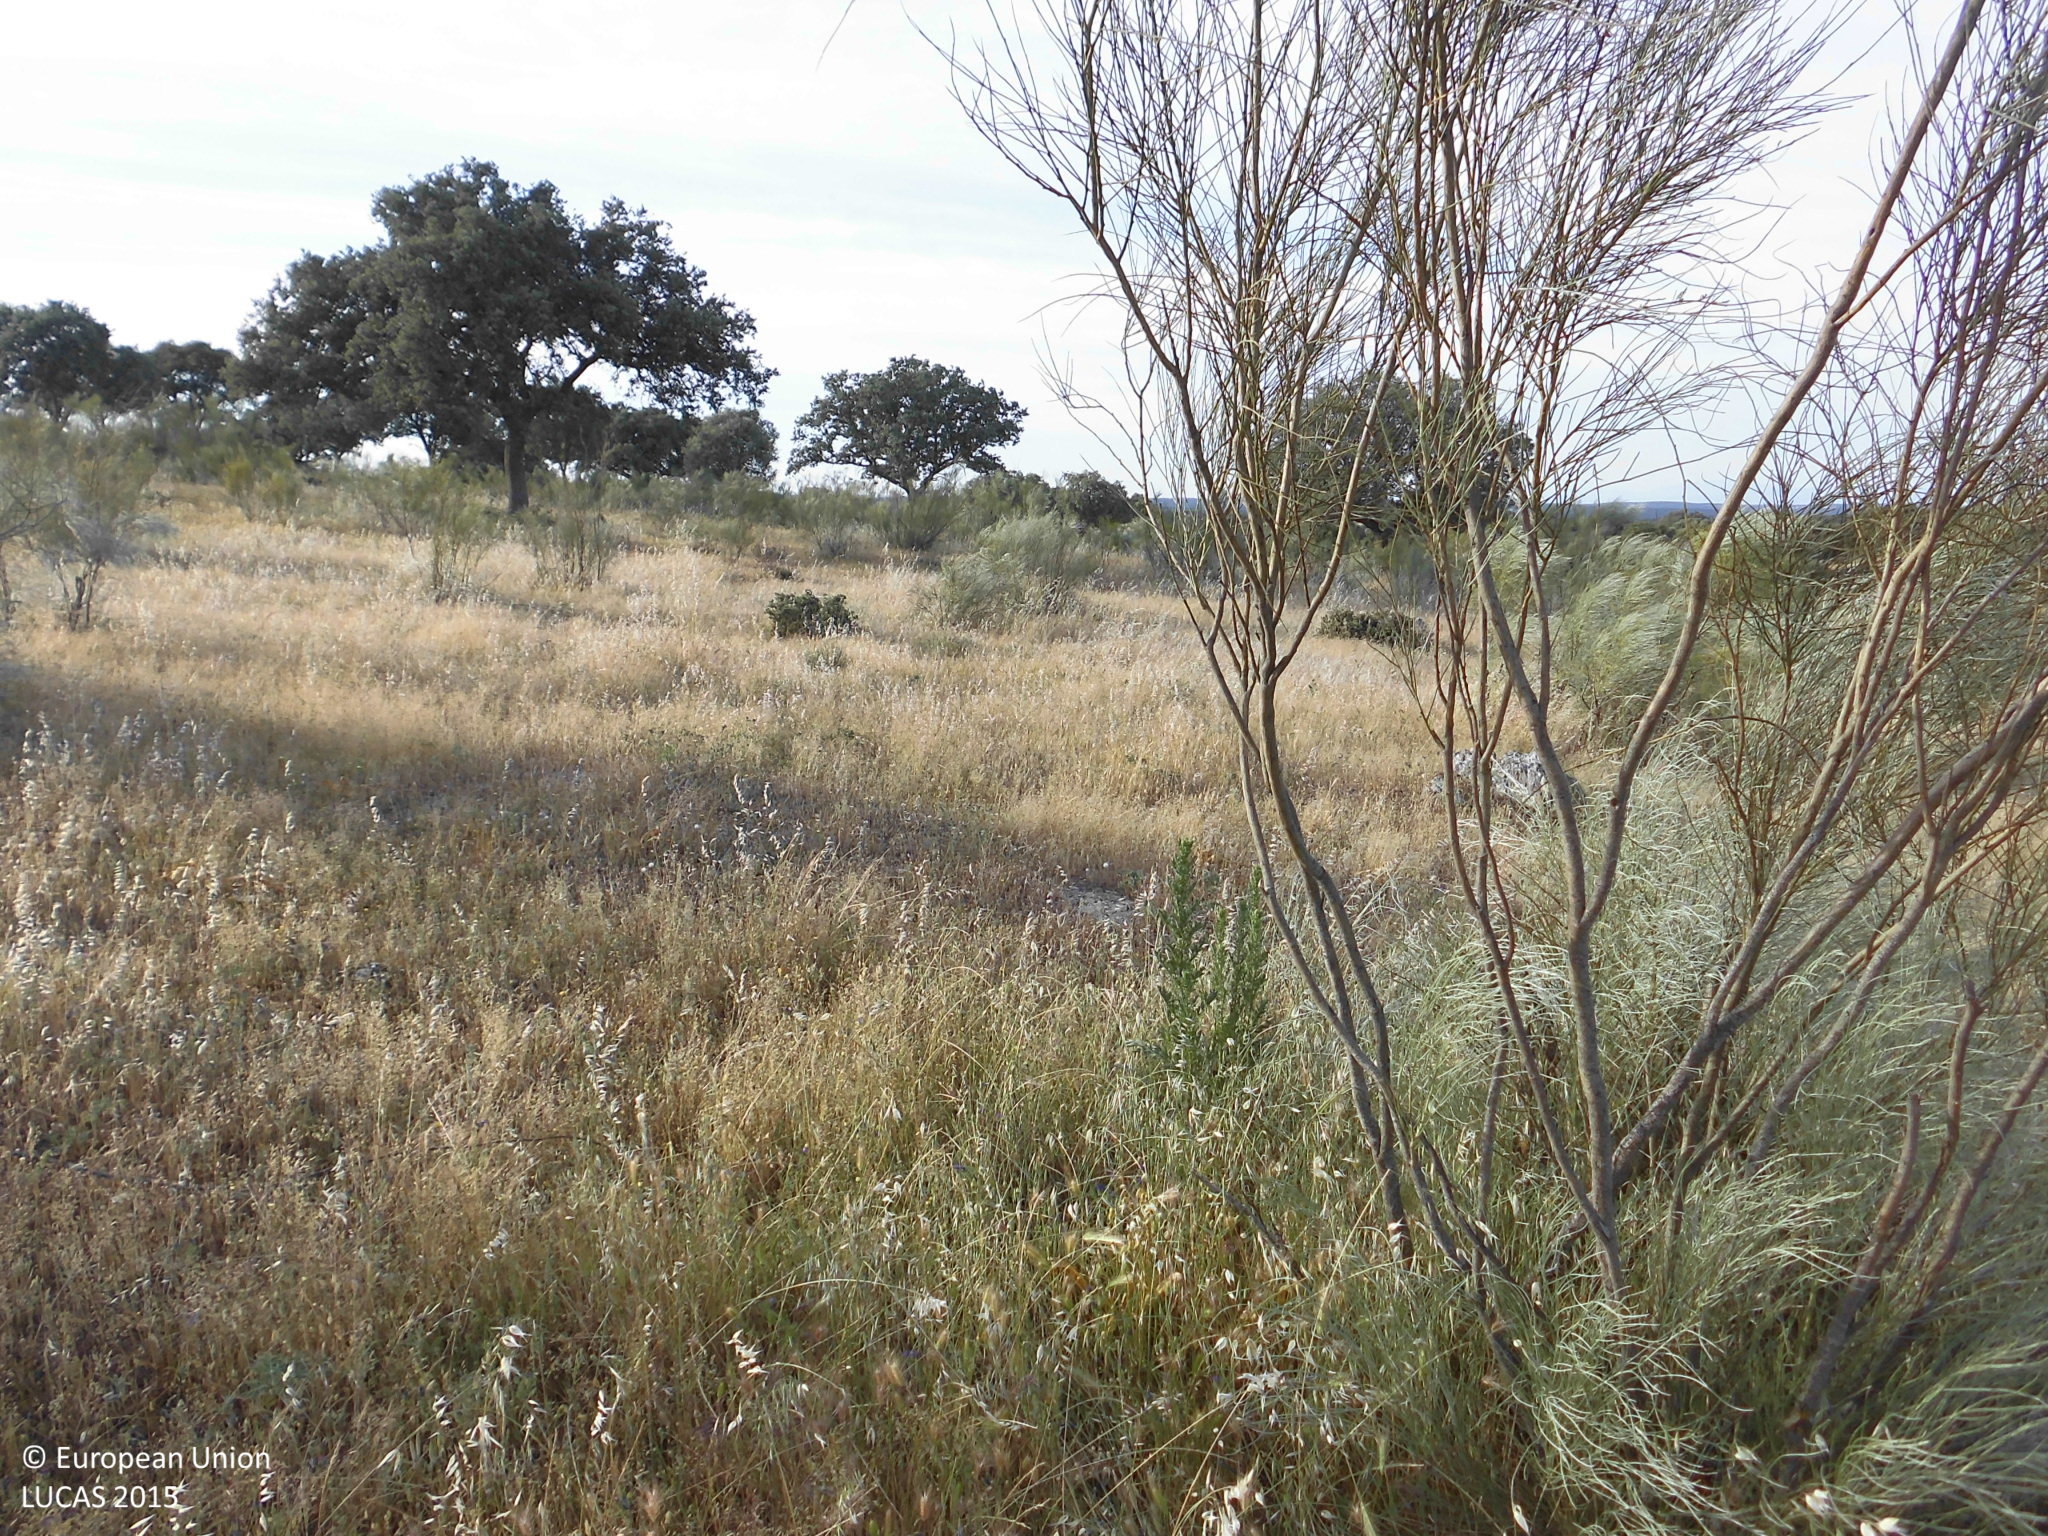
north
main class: Shrubland
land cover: Shrubland without tree cover
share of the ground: 10 - 25 %
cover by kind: herbaceous plants 90 %, shrubs 10 %
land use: Agriculture (excluding fallow land and kitchen gardens)
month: May
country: ES
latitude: 39.5693
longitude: -6.1167
